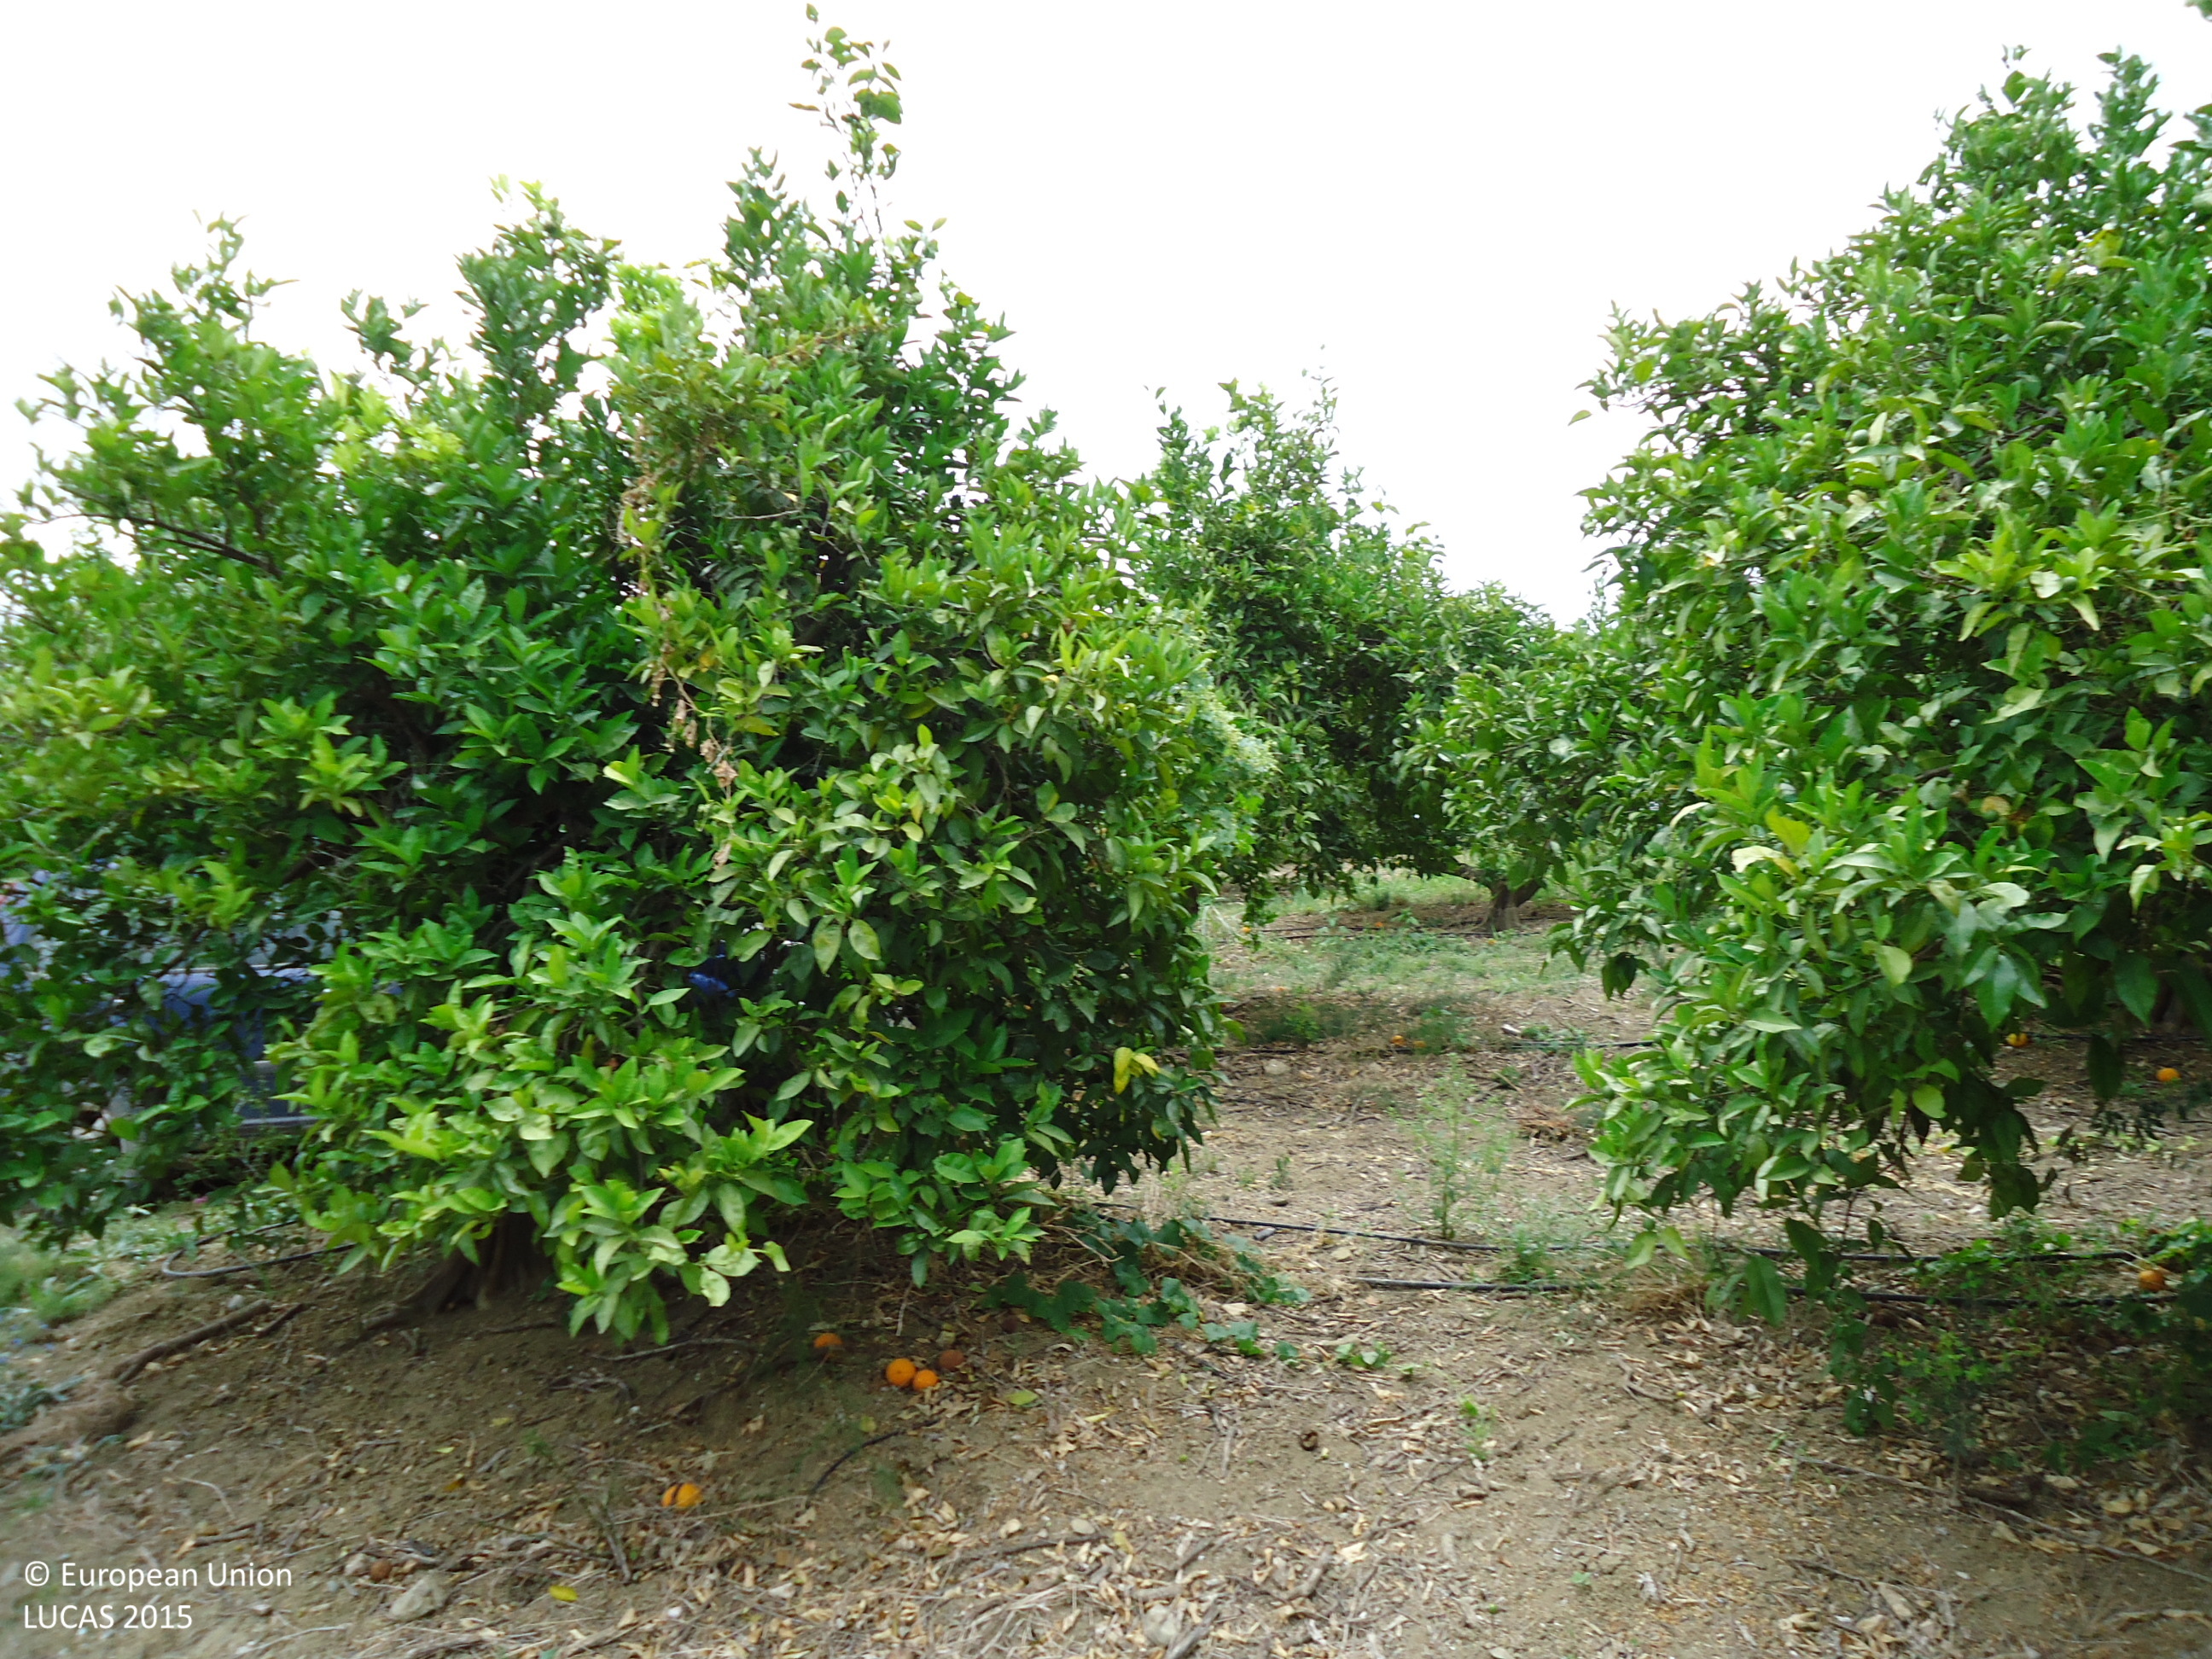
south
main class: Cropland
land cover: Oranges
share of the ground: > 75 %
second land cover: Spontaneously vegetated surfaces
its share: > 75 %
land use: Agriculture (excluding fallow land and kitchen gardens)
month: June
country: ES
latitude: 36.4226
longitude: -5.3310
